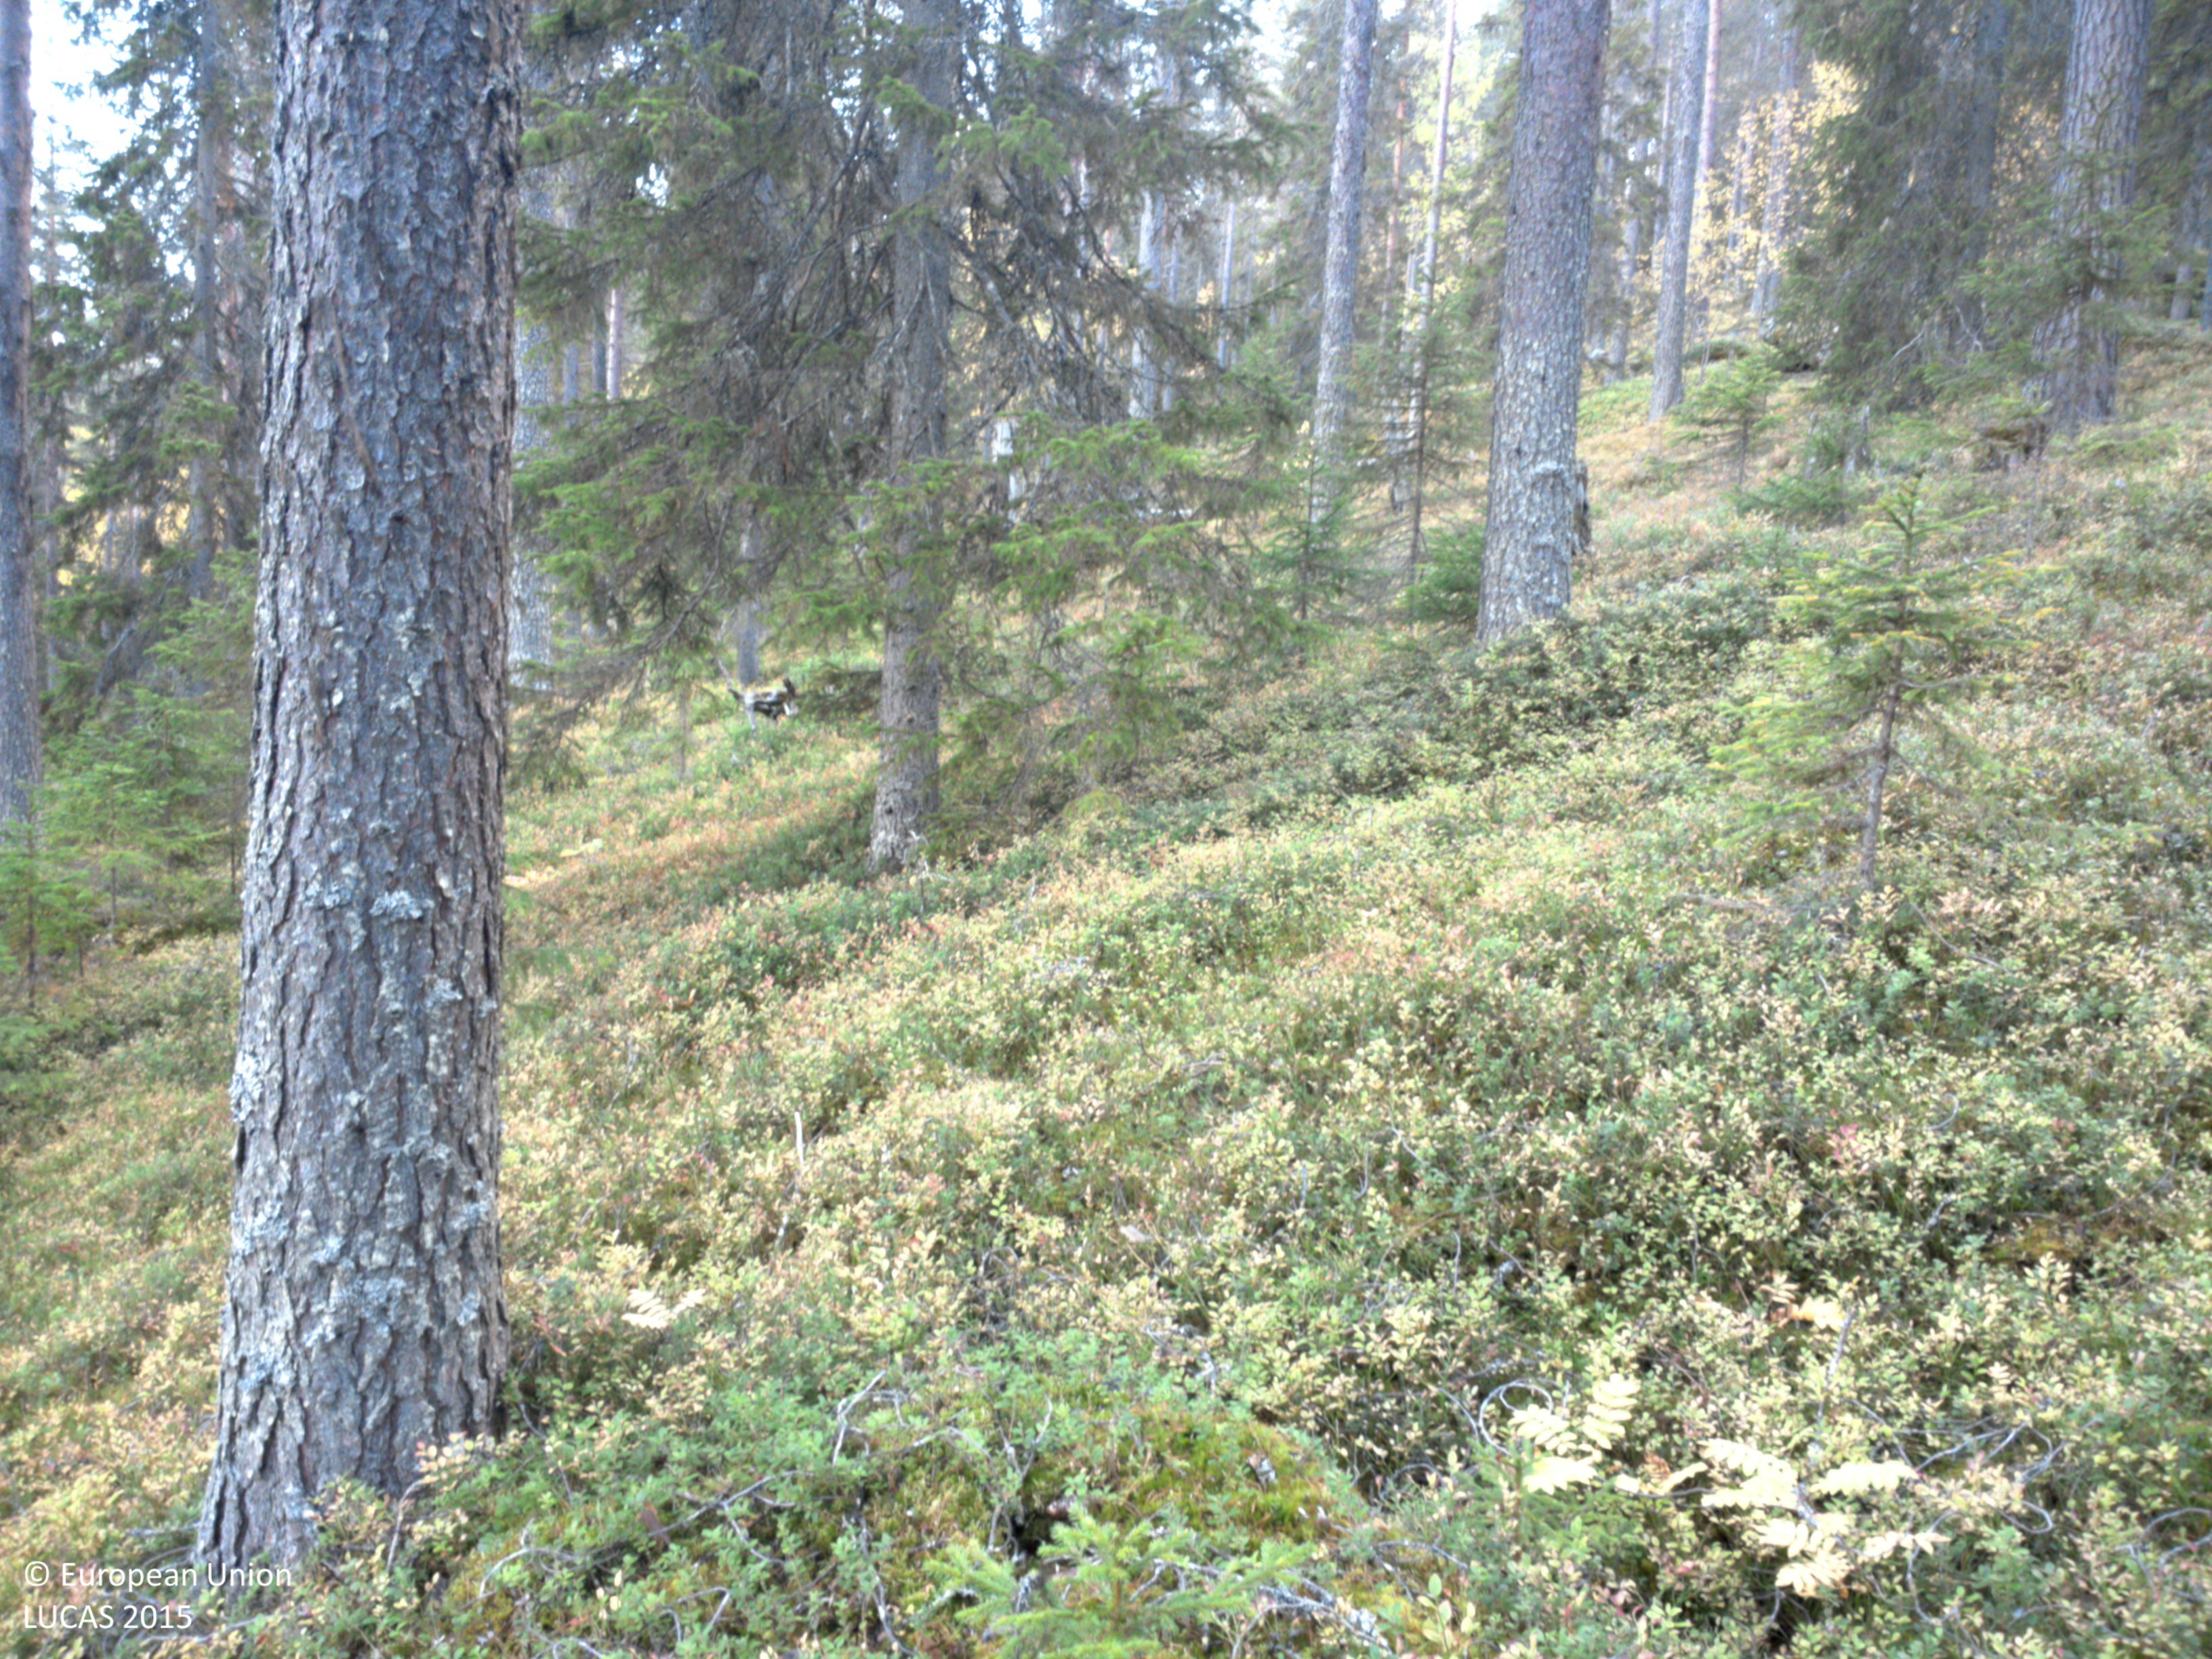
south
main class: Woodland
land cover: Other coniferous woodland
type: boreal forest
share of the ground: 50 - 75 %
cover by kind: coniferous forest trees 70 %, shrubs 20 %, lichens and mosses 10 %
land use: Forestry
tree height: > 5 m
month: September
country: SE
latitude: 64.9680
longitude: 18.5431
